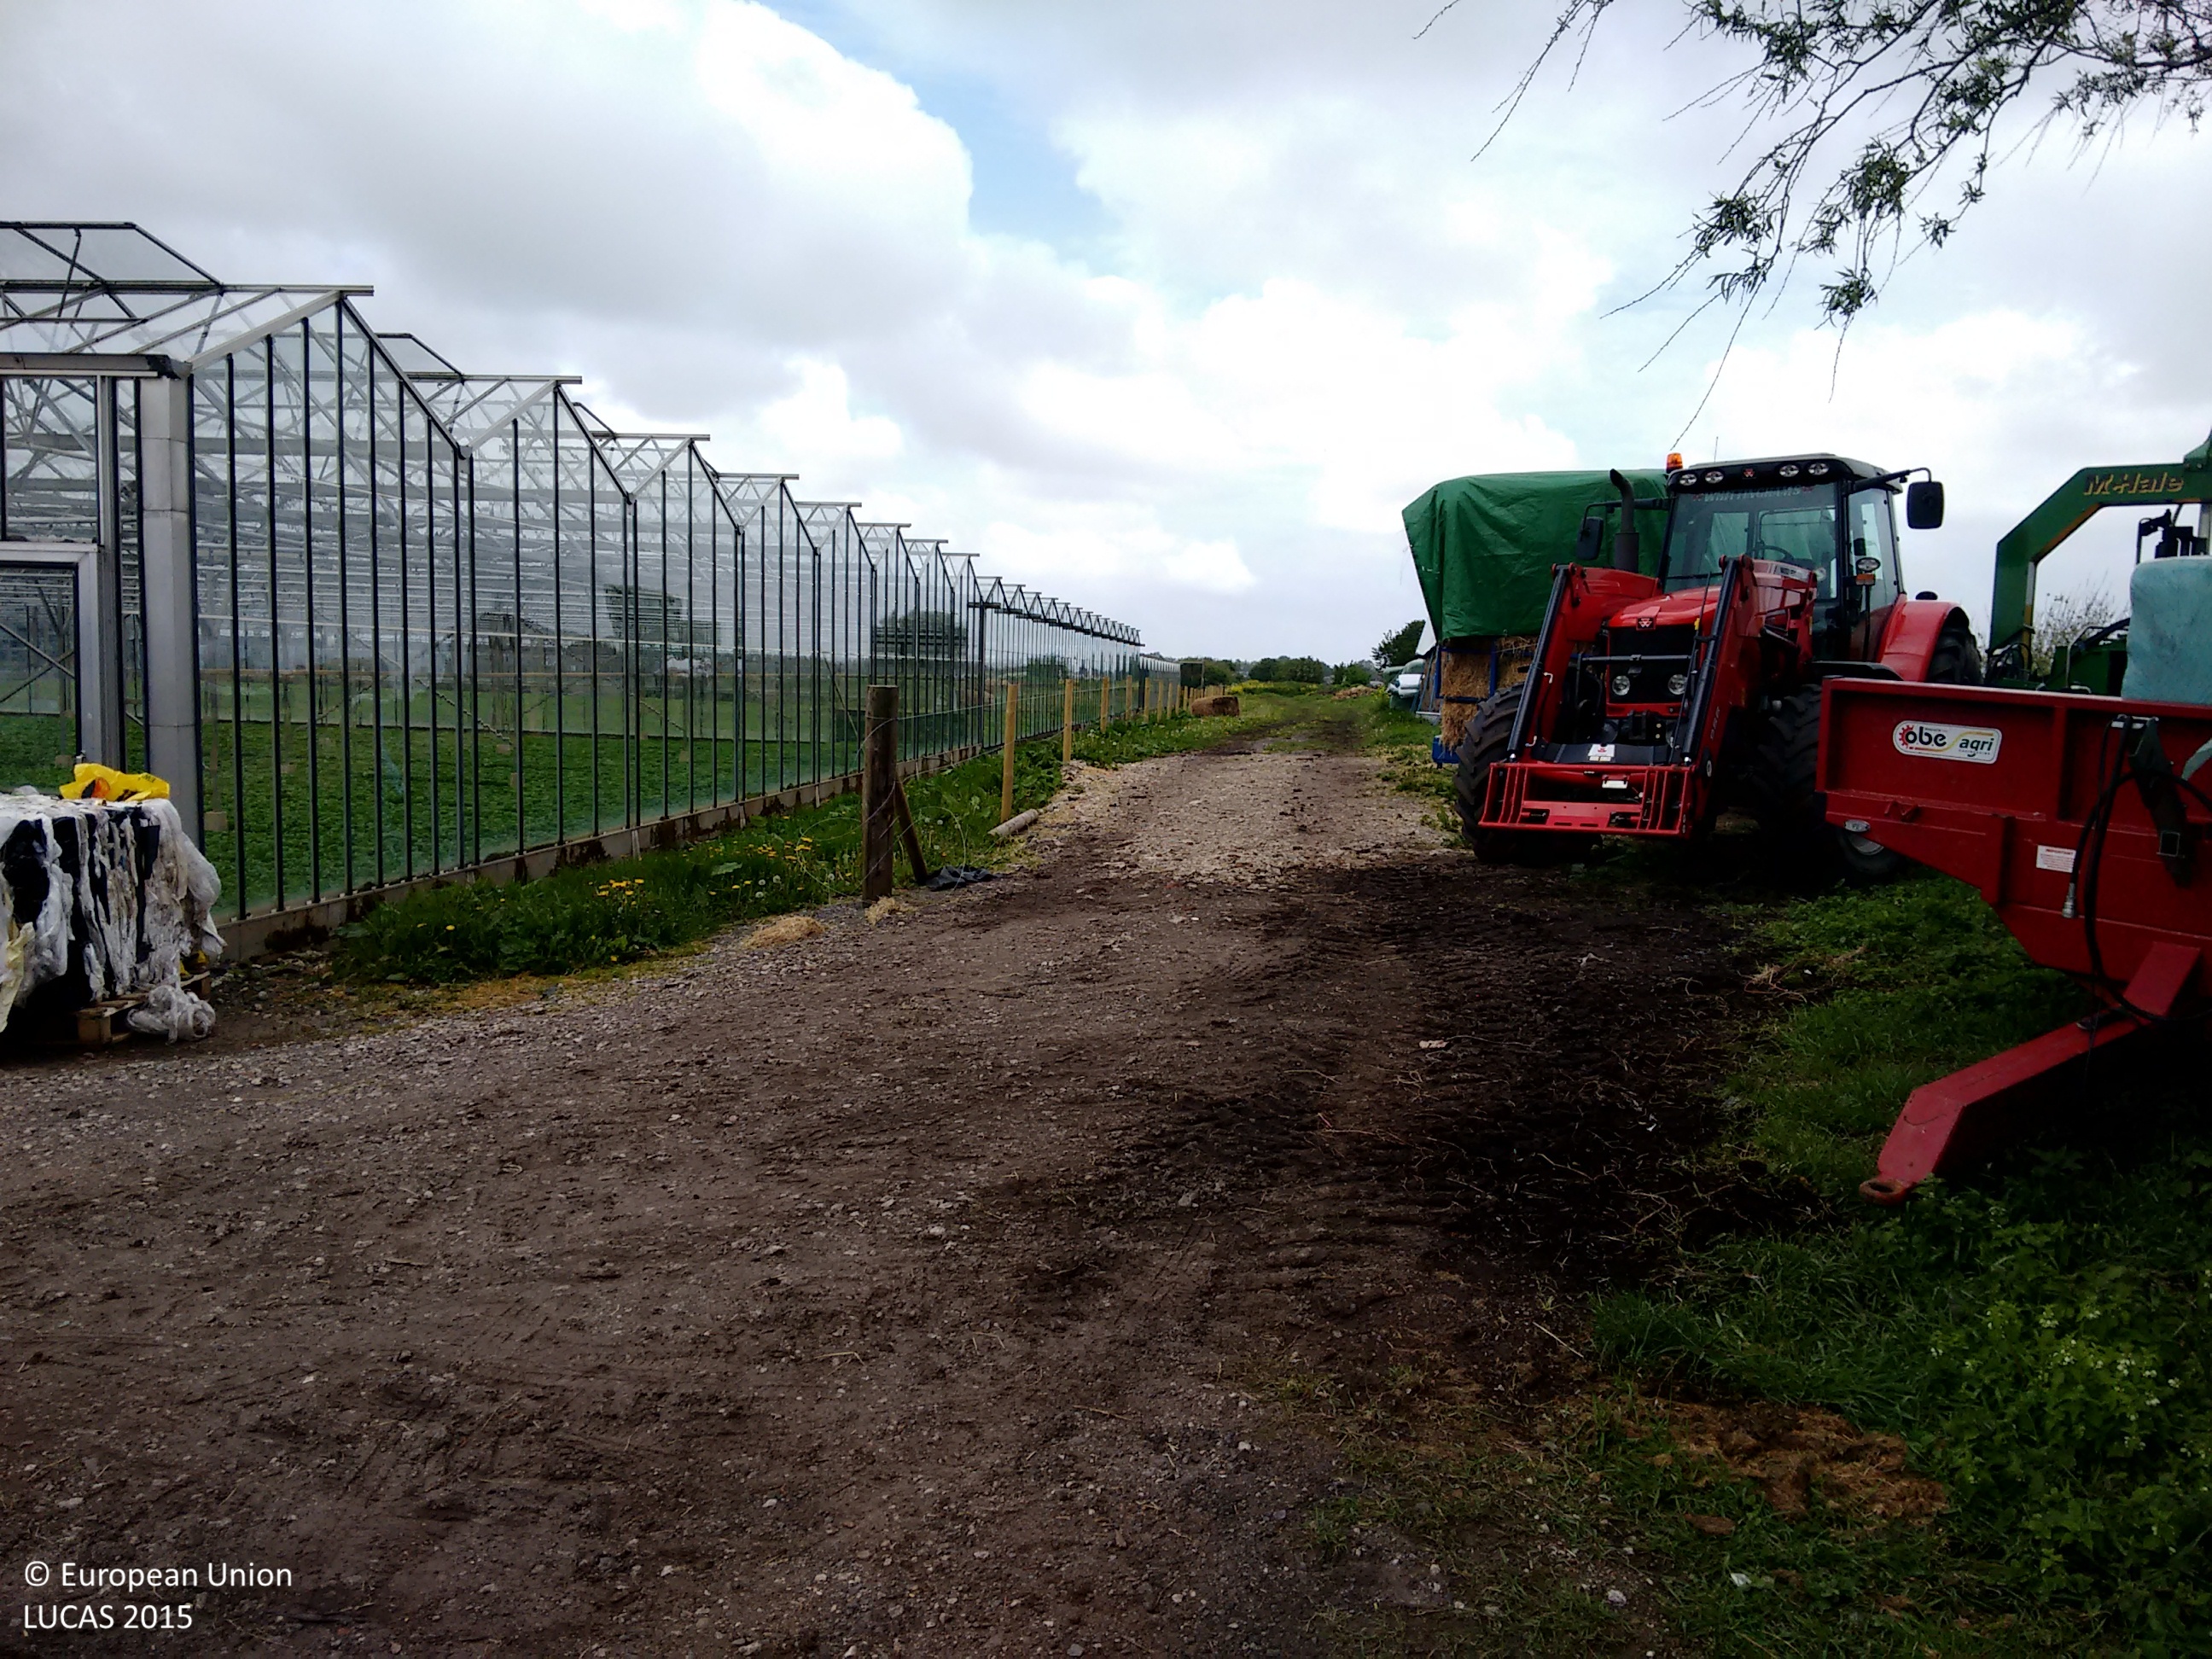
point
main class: Artificial land
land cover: Greenhouses
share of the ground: > 75 %
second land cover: Strawberries
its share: > 75 %
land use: Agriculture (excluding fallow land and kitchen gardens)
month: May
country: GB
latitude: 53.6954
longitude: -2.8693
